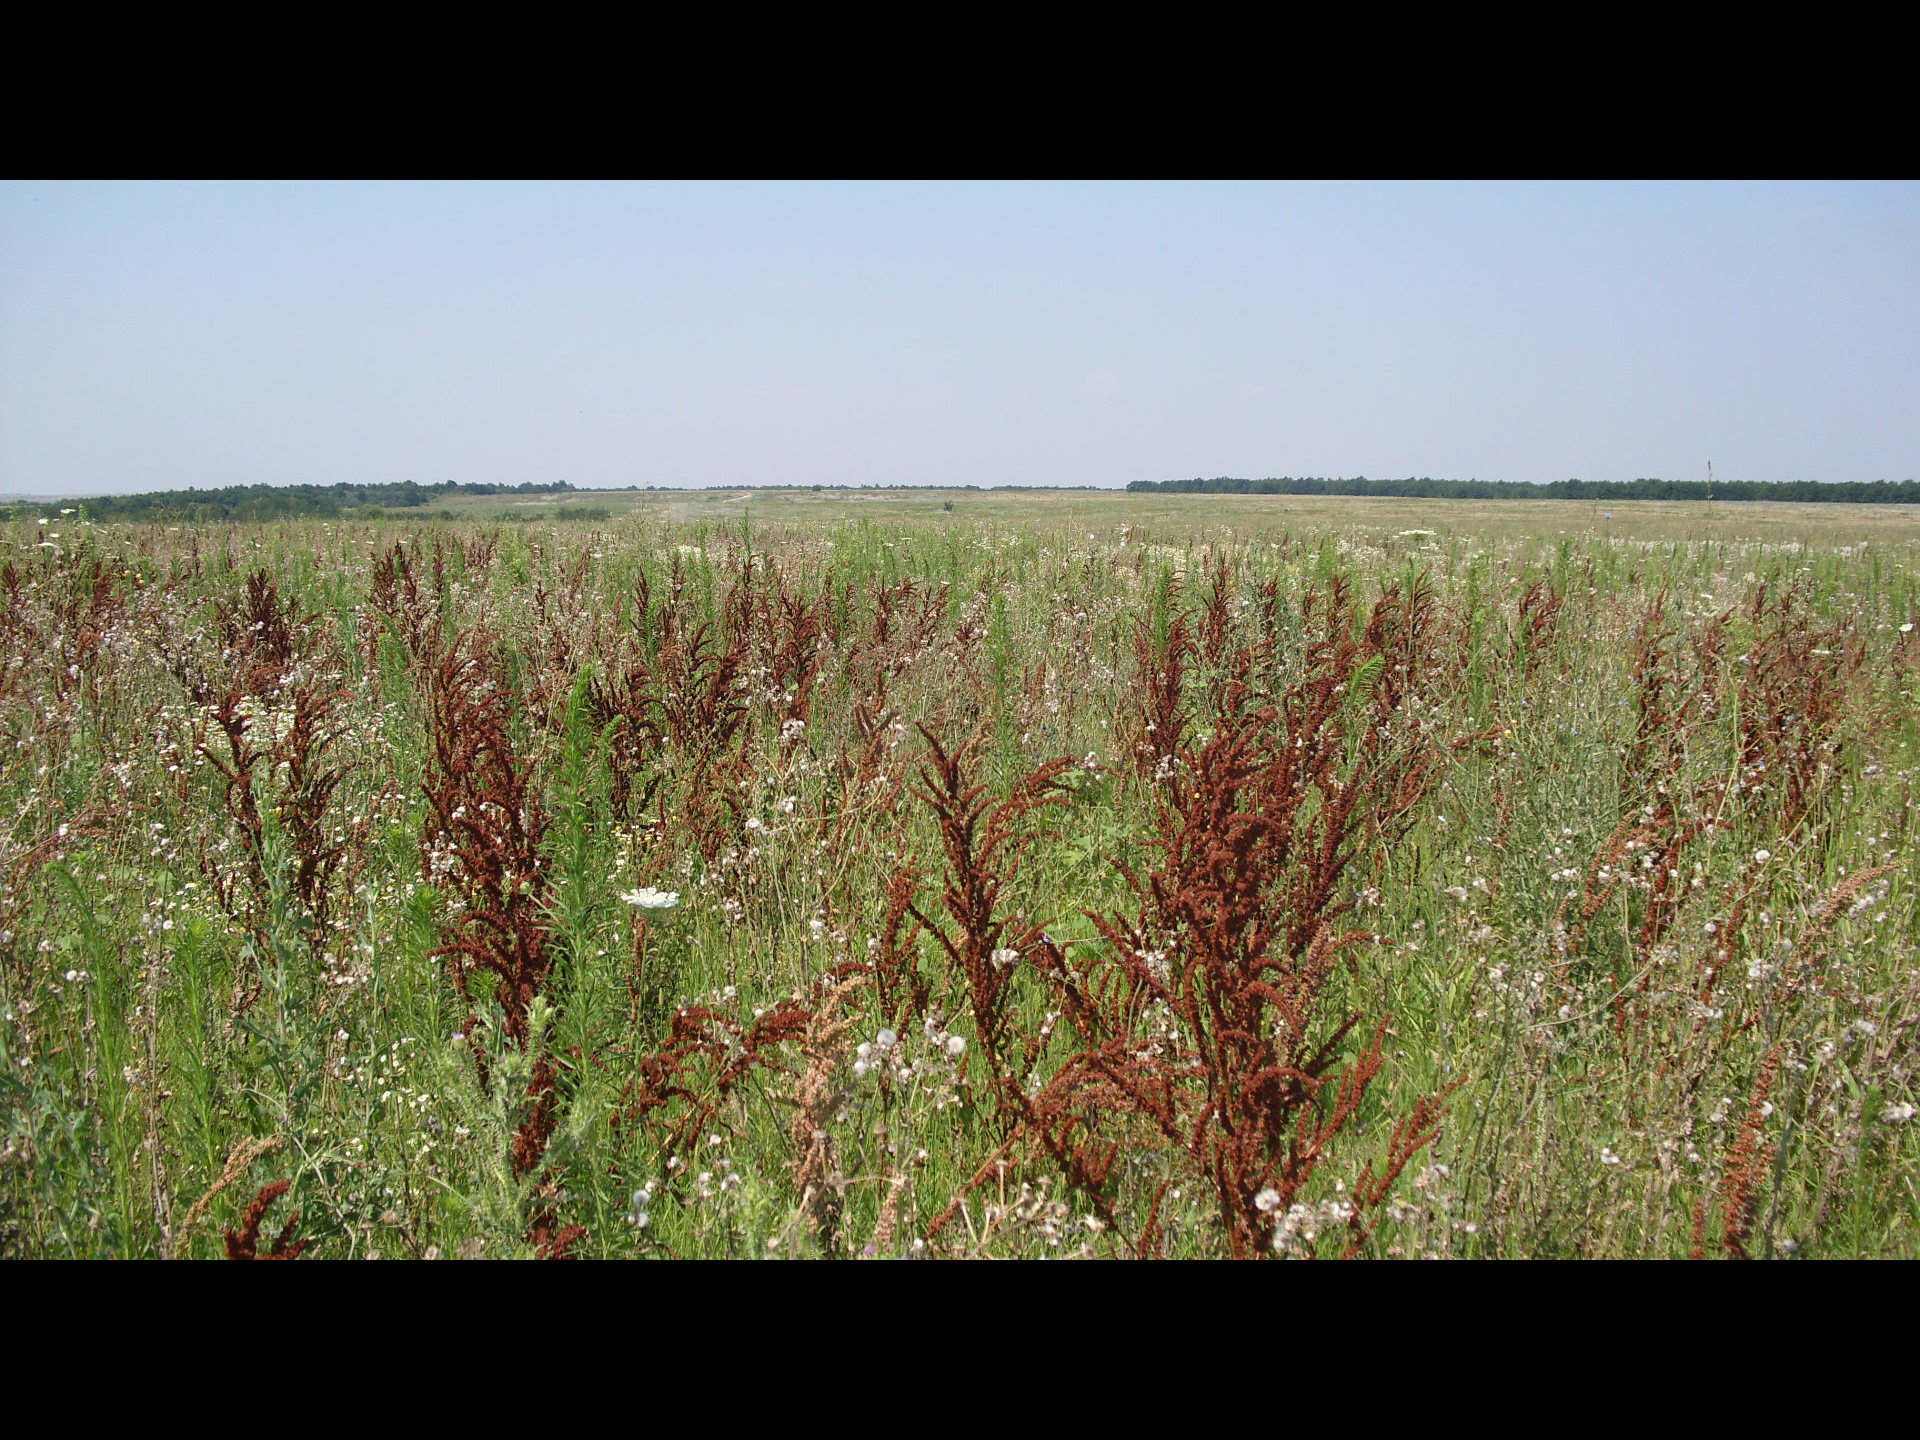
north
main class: Grassland
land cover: Spontaneously vegetated surfaces
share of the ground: > 75 %
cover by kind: herbaceous plants 100 %
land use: Fallow land
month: July
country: BG
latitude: 43.7228
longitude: 22.9103
